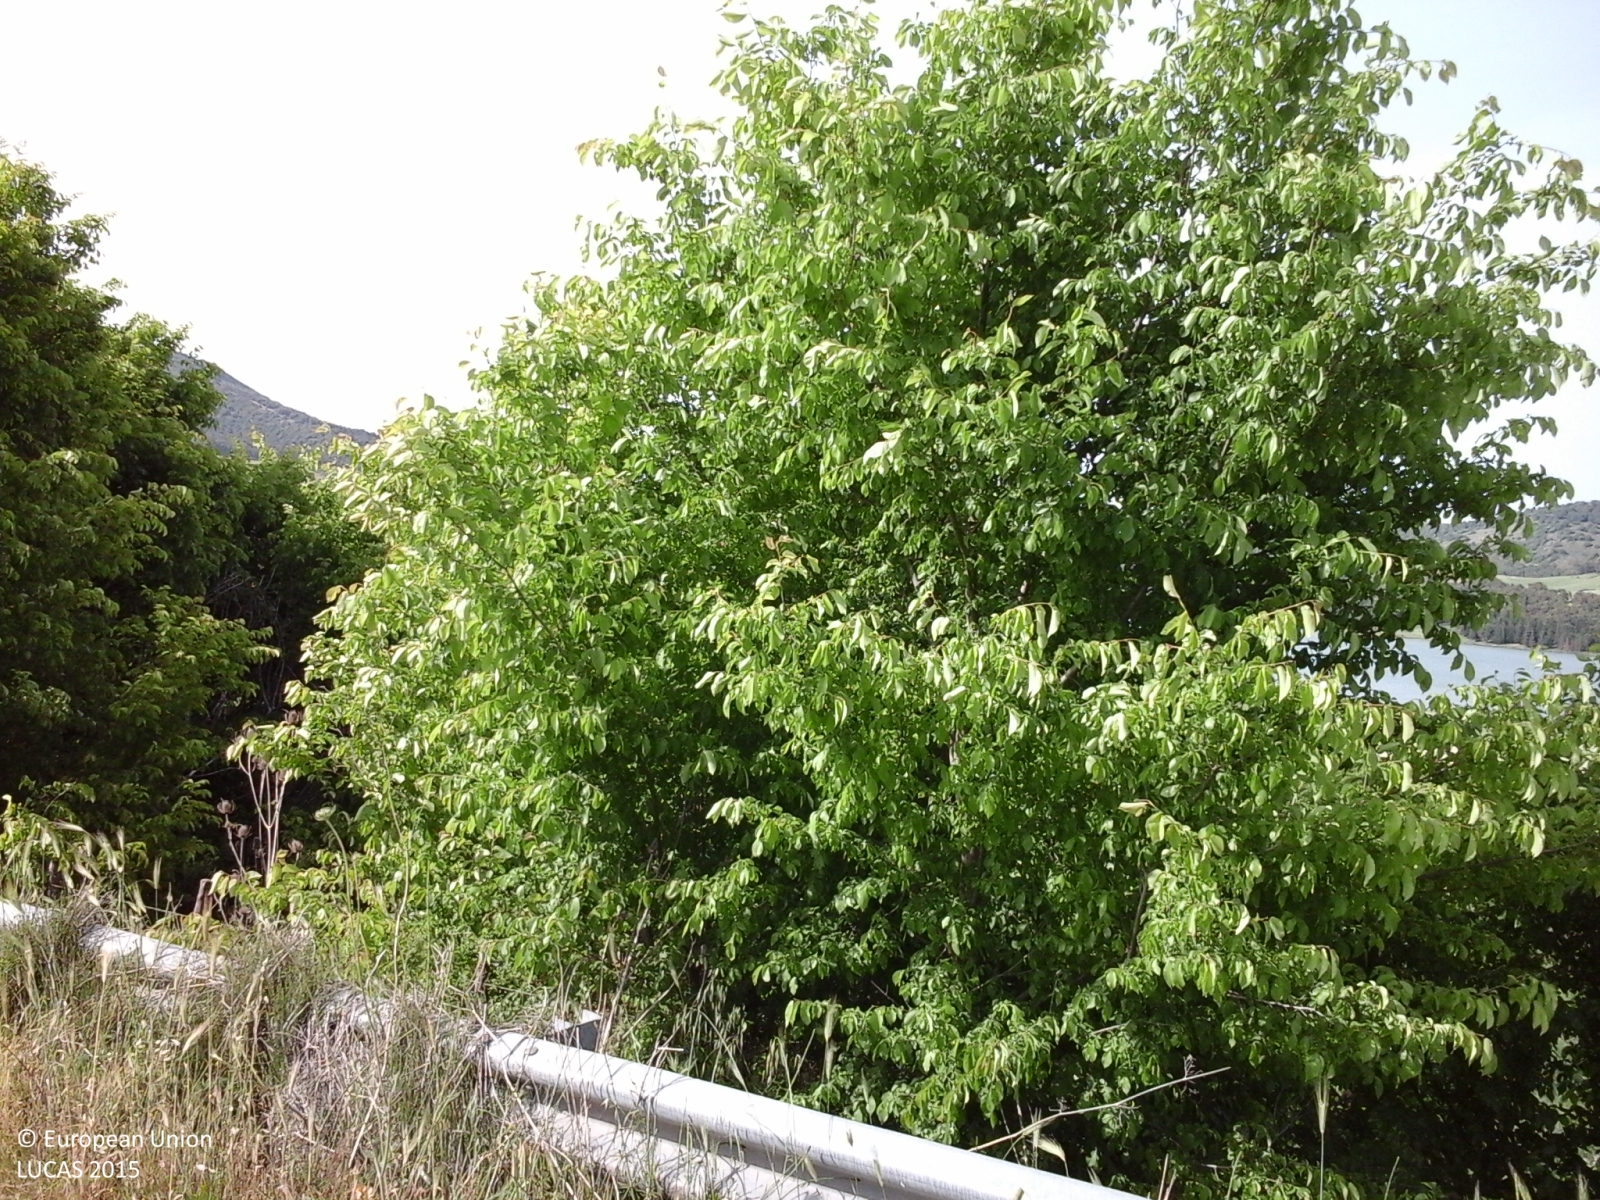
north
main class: Cropland
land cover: Mixed cereals for fodder
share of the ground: > 75 %
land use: Agriculture (excluding fallow land and kitchen gardens)
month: May
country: IT
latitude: 37.6452
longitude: 13.5437
